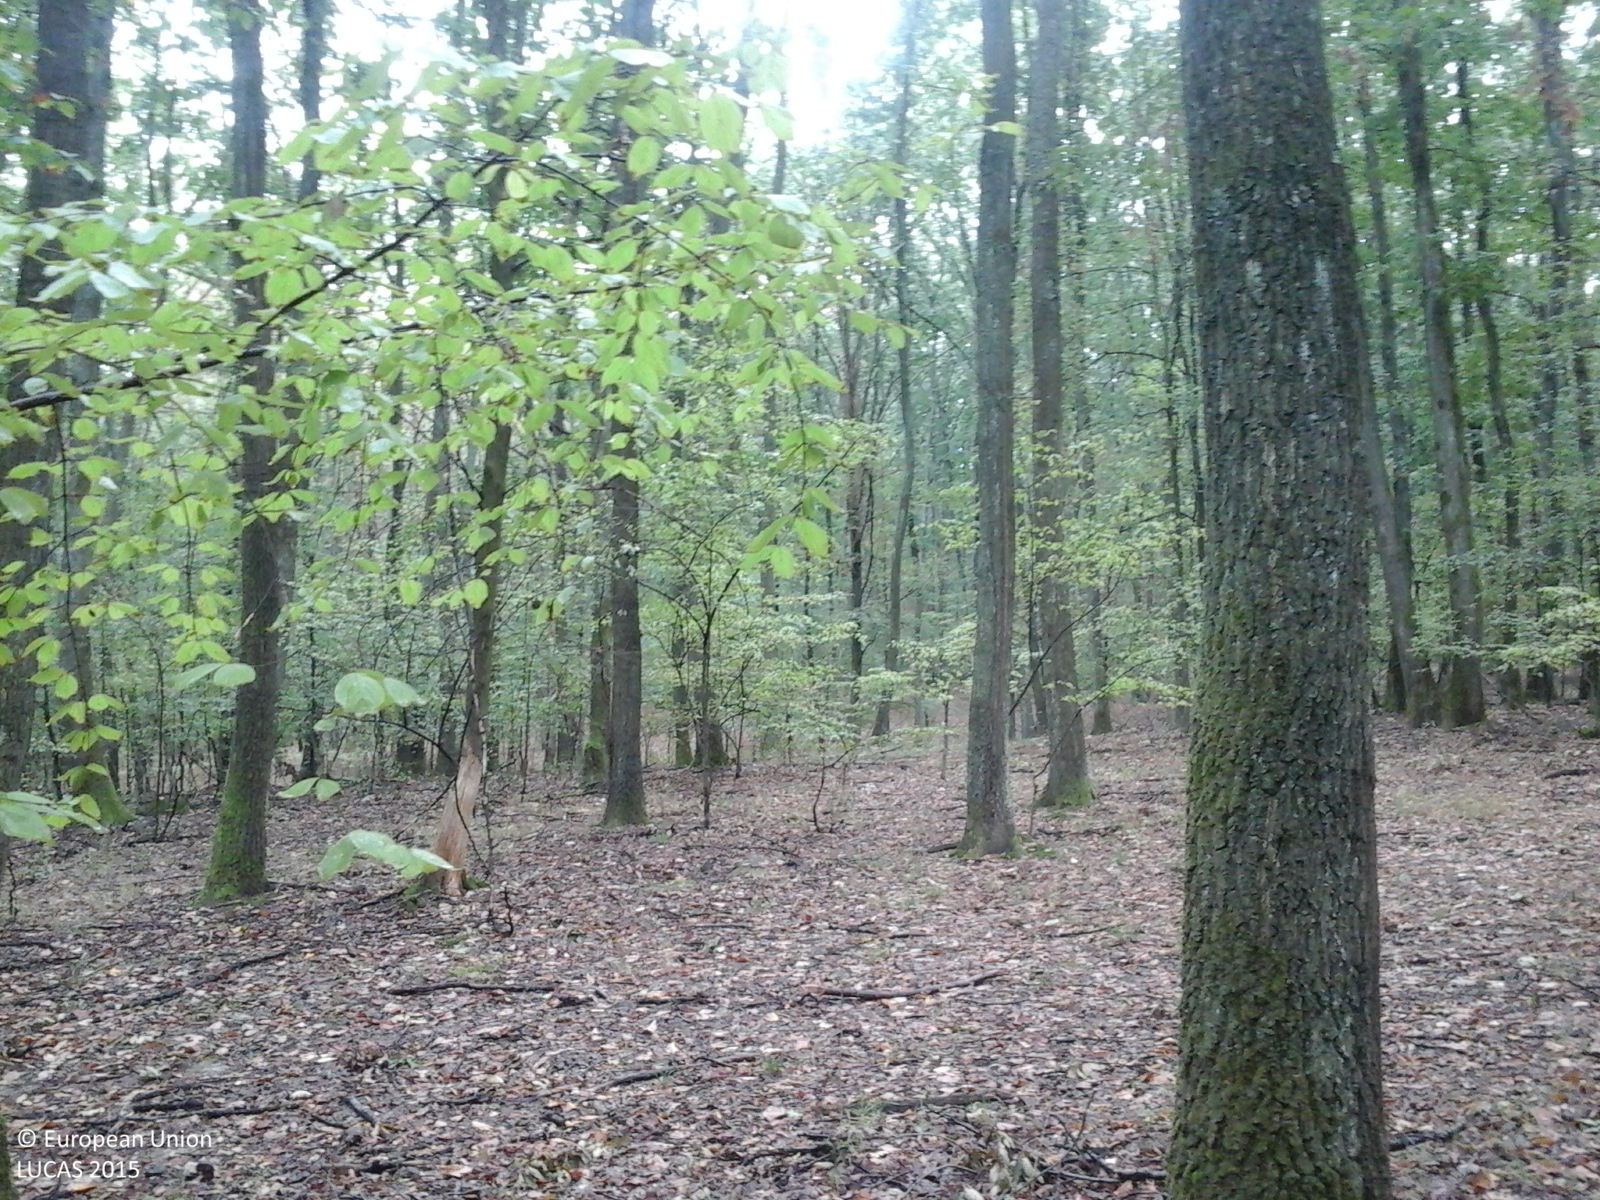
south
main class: Woodland
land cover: Broadleaved woodland
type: acidophilous oak and oak-birch forest
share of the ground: > 75 %
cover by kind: broadleaved forest trees 100 %
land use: Forestry
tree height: > 5 m
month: September
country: RO
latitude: 47.2376
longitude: 22.3248
